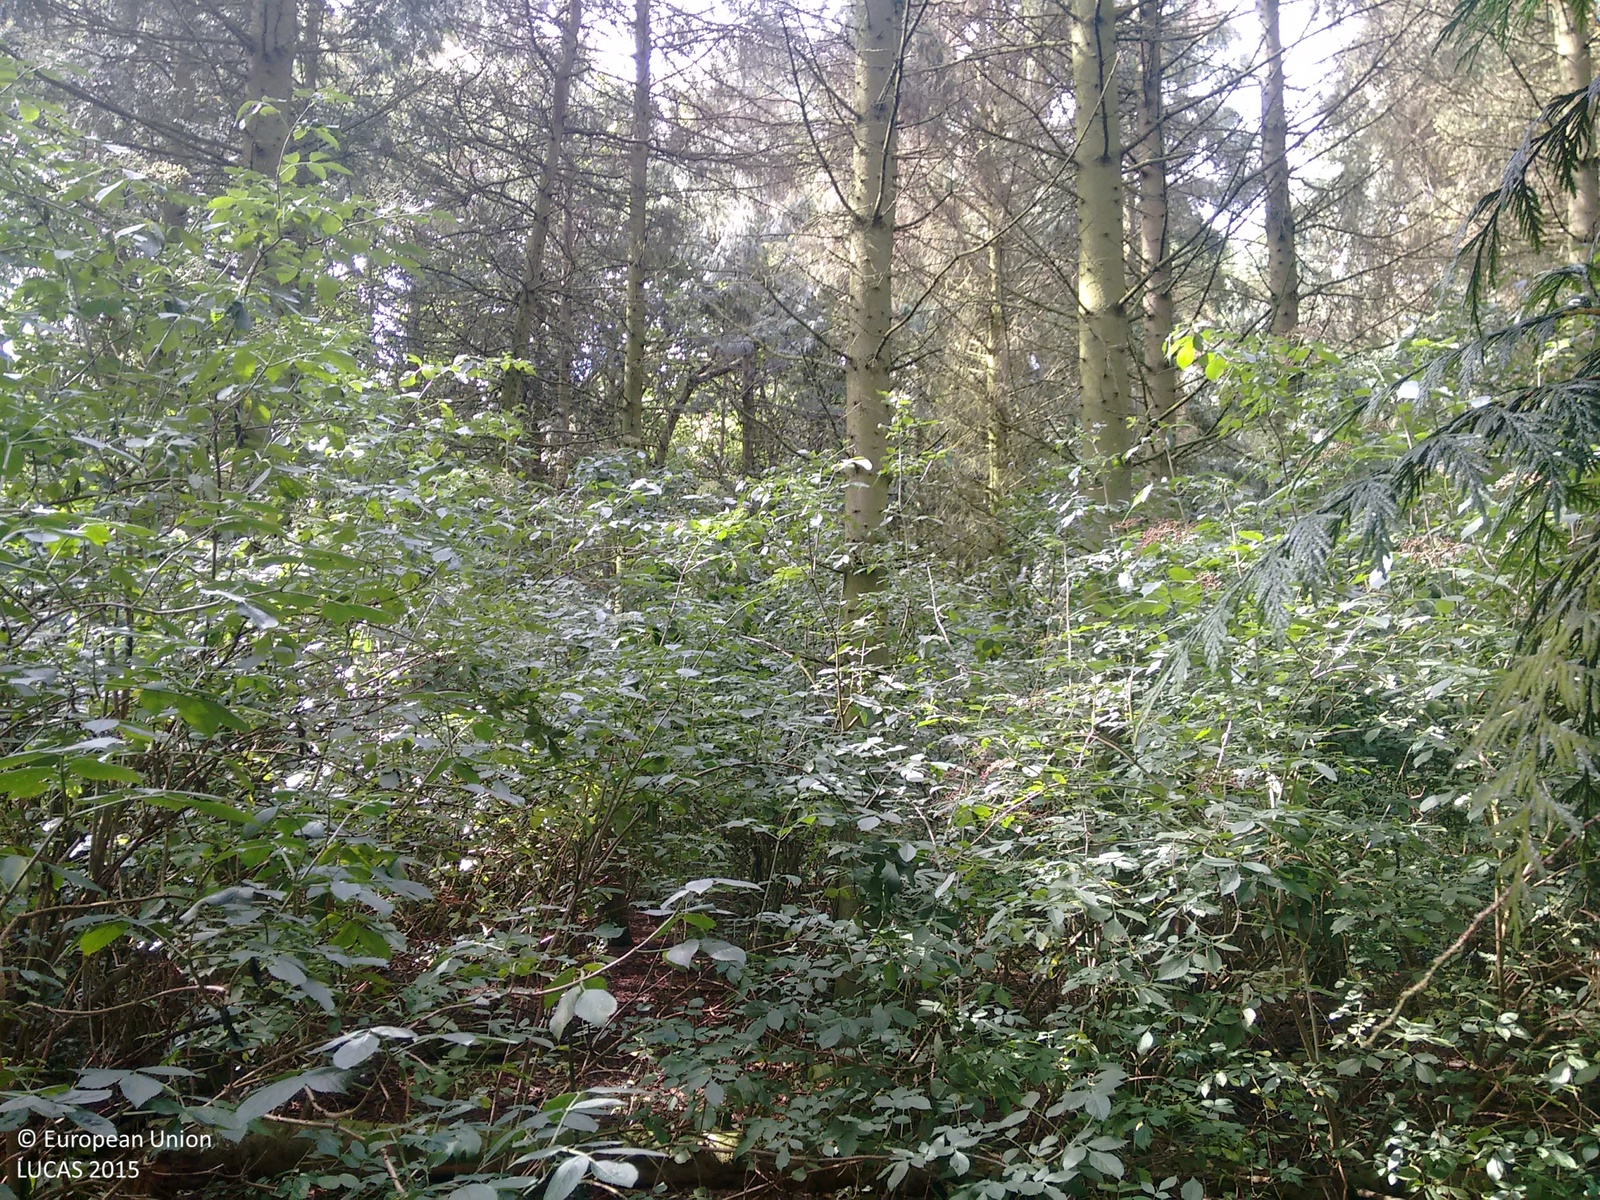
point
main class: Woodland
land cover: Other coniferous woodland
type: exotic forest
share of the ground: > 75 %
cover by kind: coniferous forest trees 85 %, shrubs 10 %, broadleaved forest trees 5 %
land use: Semi-natural and natural areas not in use
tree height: > 5 m
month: August
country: GB
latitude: 52.1598
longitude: 0.5146
